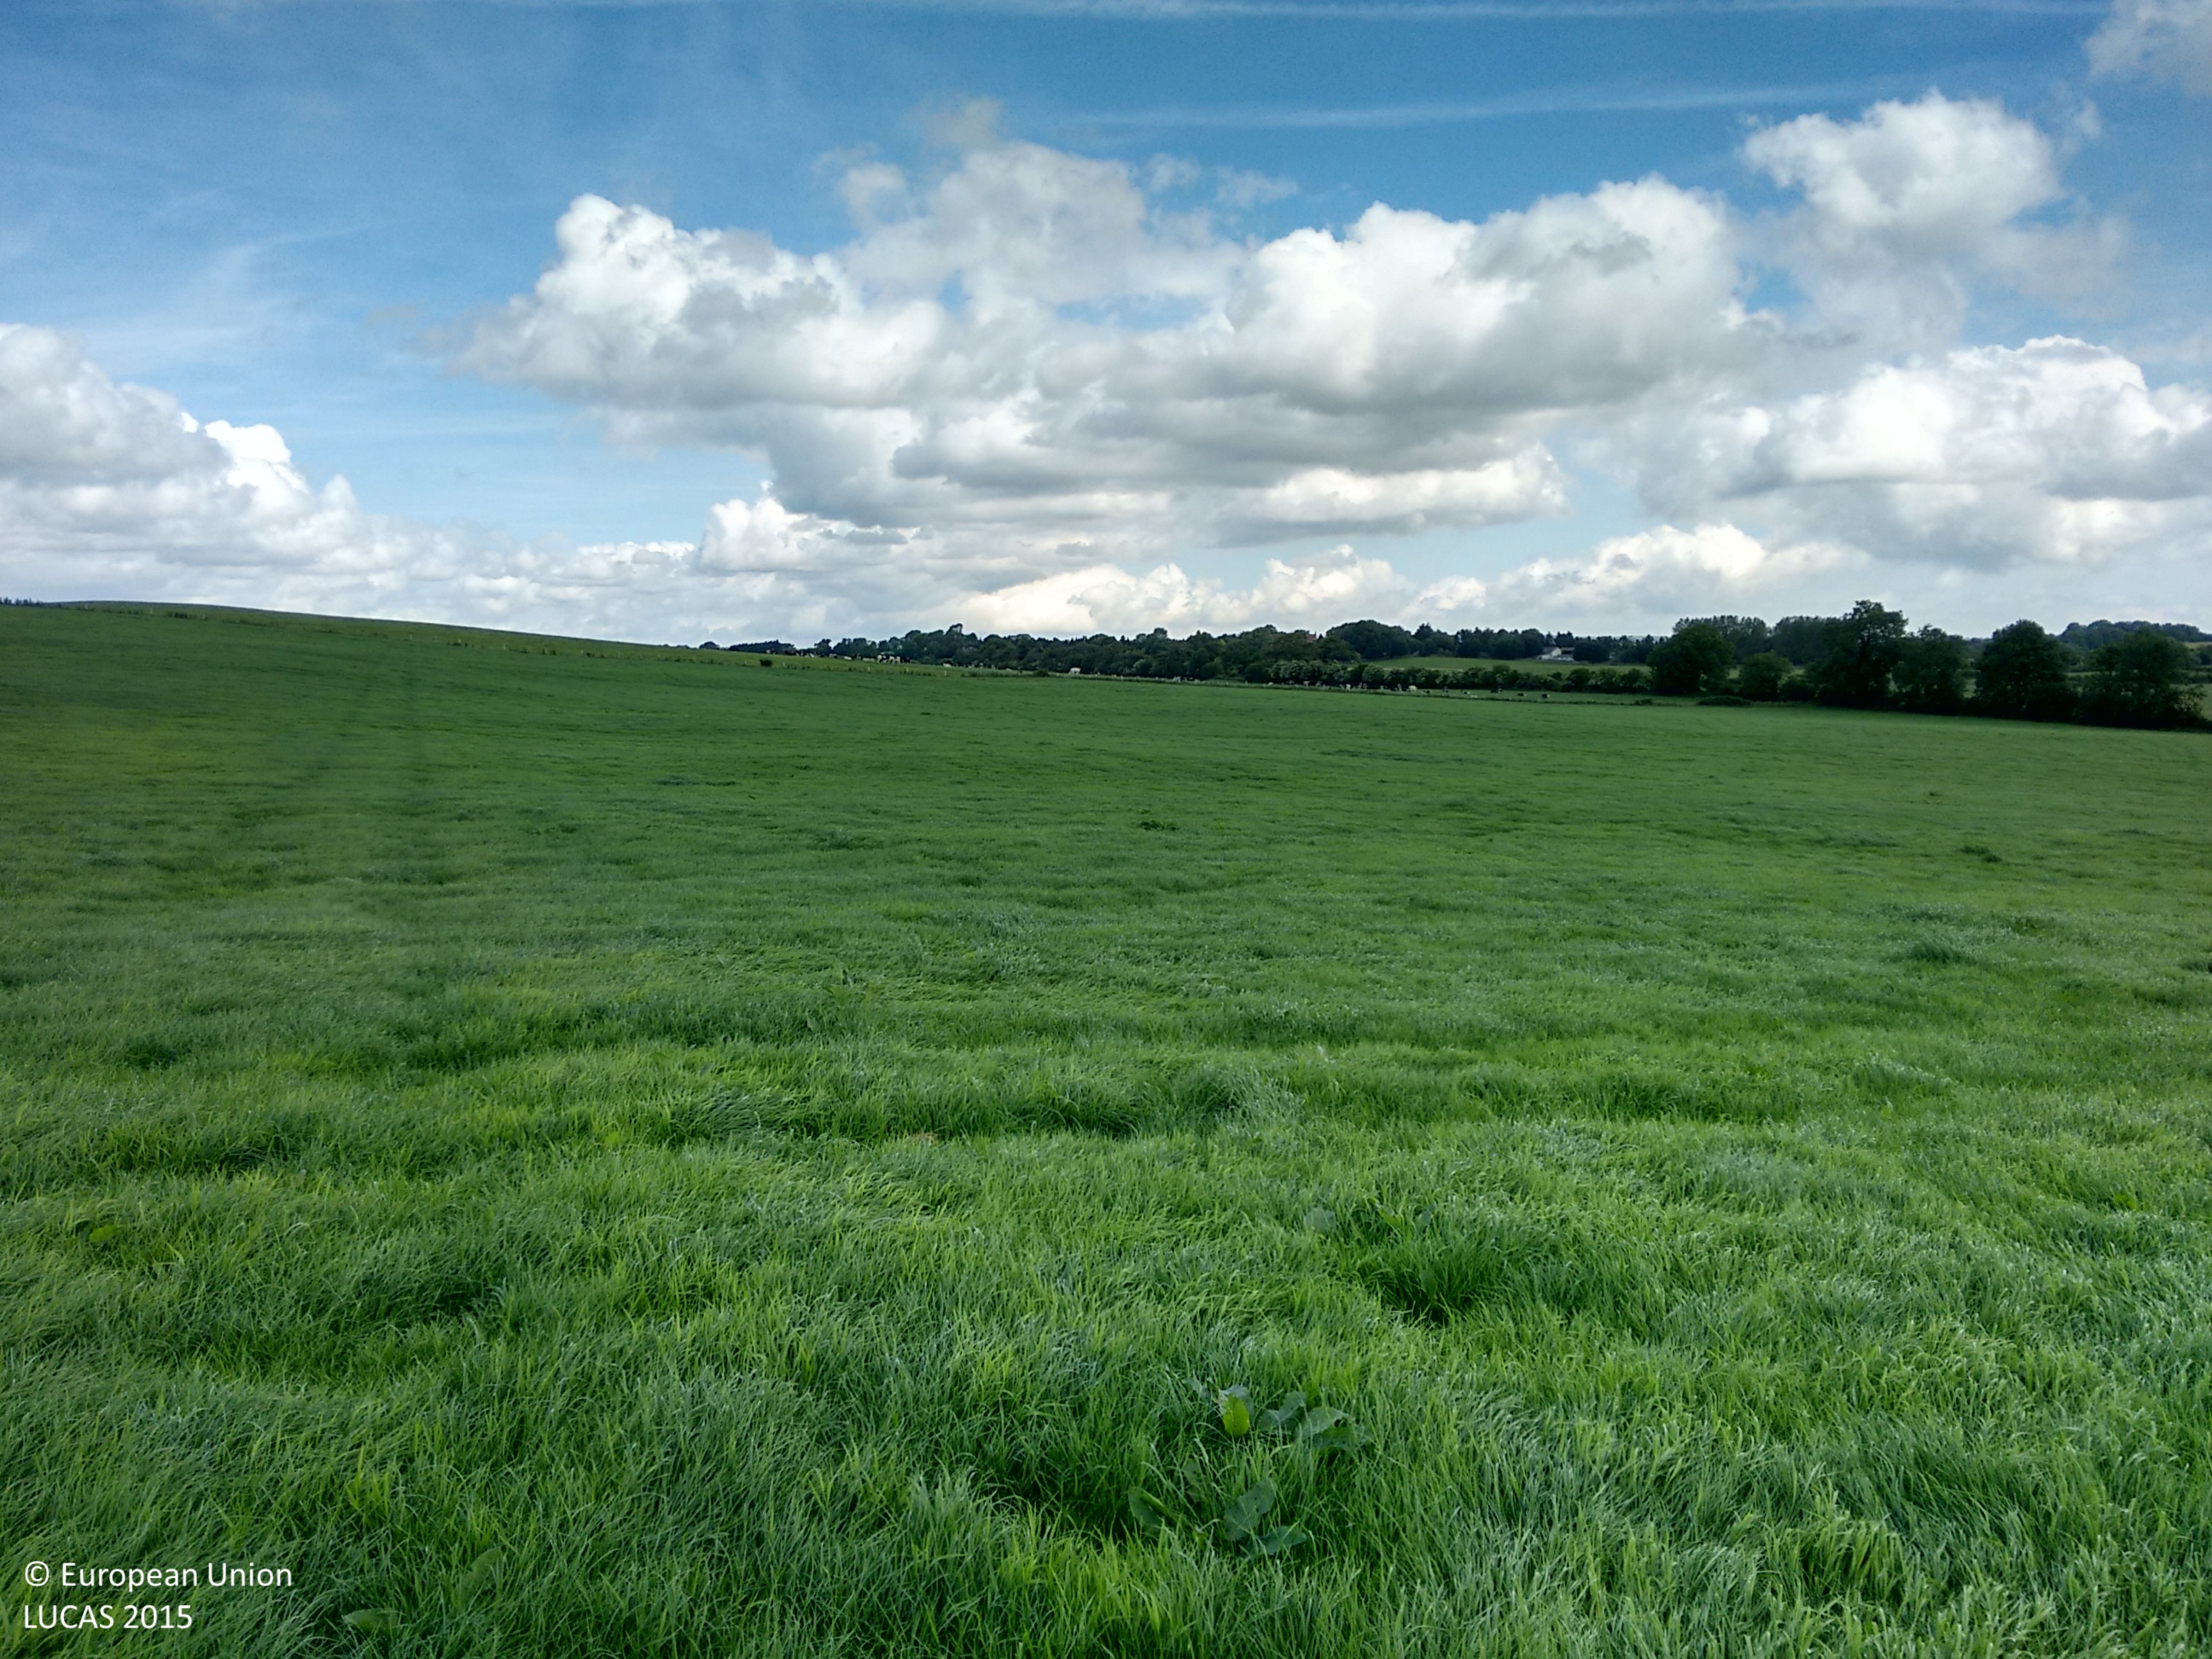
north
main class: Grassland
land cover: Grassland without tree/shrub cover
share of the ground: > 75 %
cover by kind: herbaceous plants 100 %
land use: Agriculture (excluding fallow land and kitchen gardens)
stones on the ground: < 10 %
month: July
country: IE
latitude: 53.7858
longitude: -6.7534
